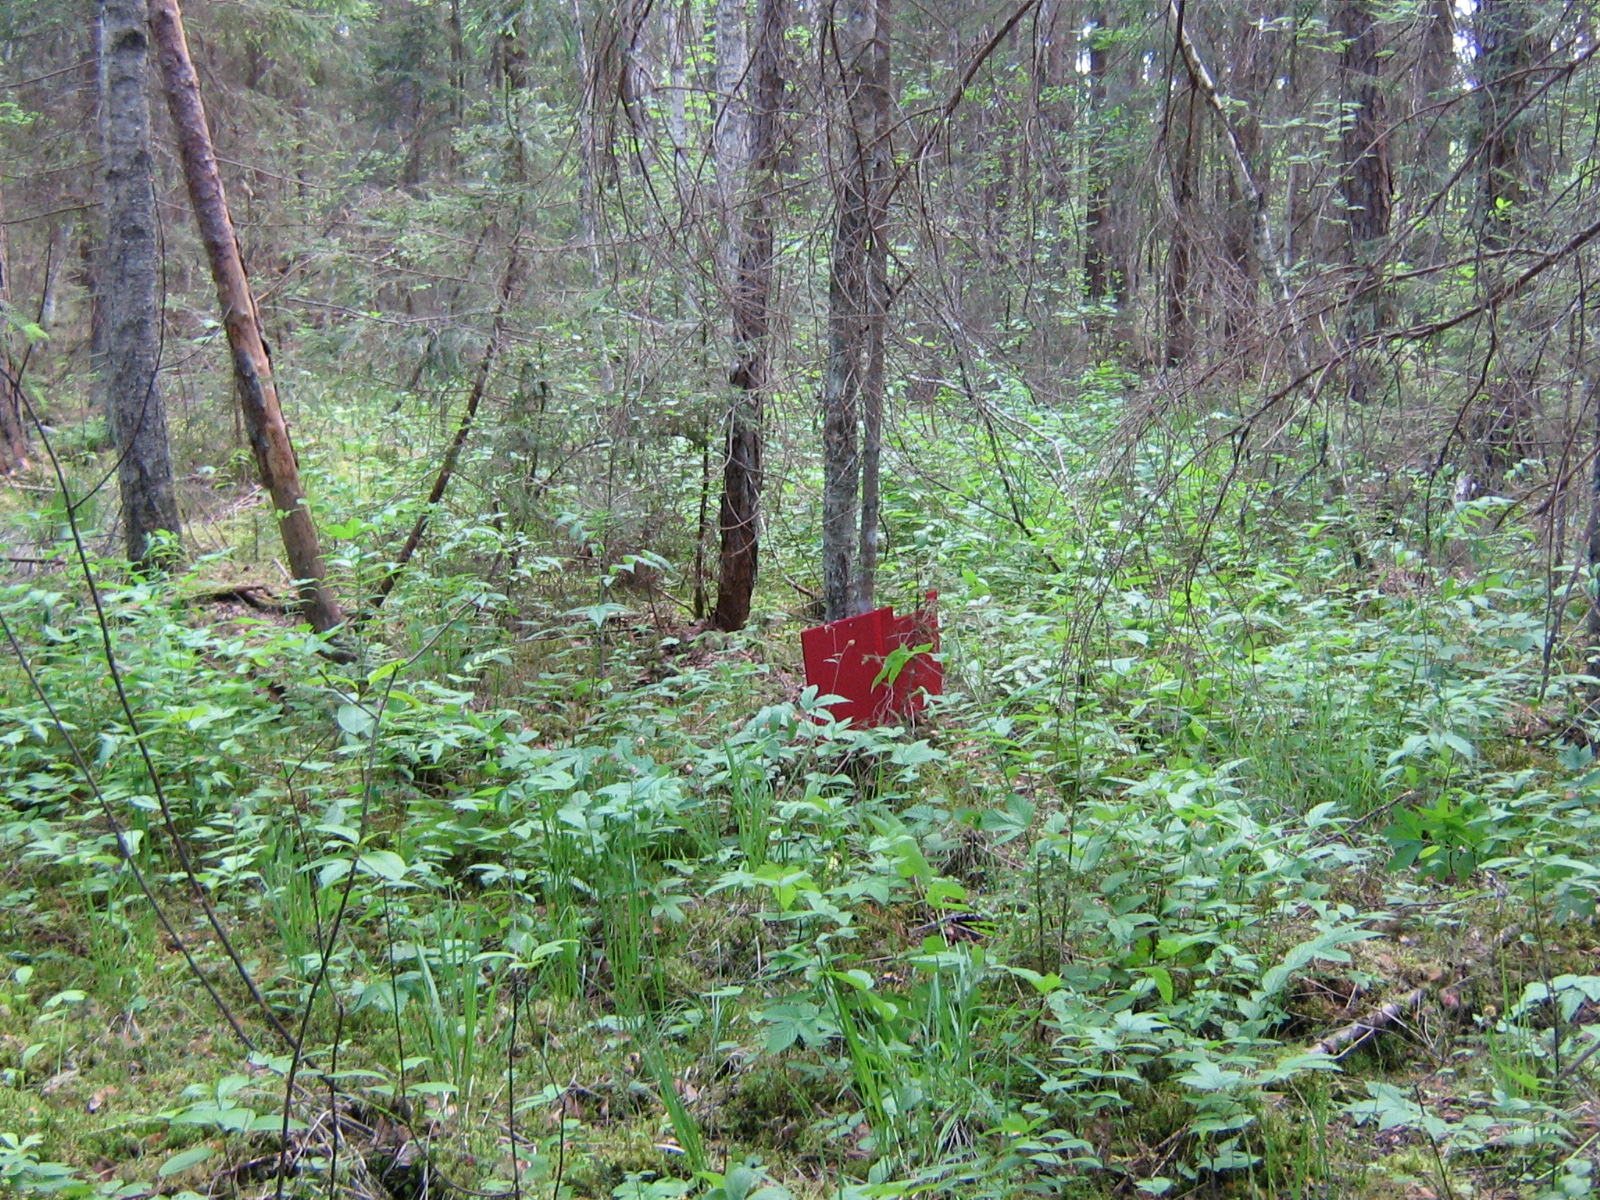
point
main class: Woodland
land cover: Spruce dominated mixed woodland
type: hemiboreal forest and nemoral coniferous forest and mixed broadleaved-coniferous forest
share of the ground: > 75 %
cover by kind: coniferous forest trees 70 %, broadleaved forest trees 30 %
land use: Forestry
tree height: > 5 m
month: June
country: LV
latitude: 57.1944
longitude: 25.8646
